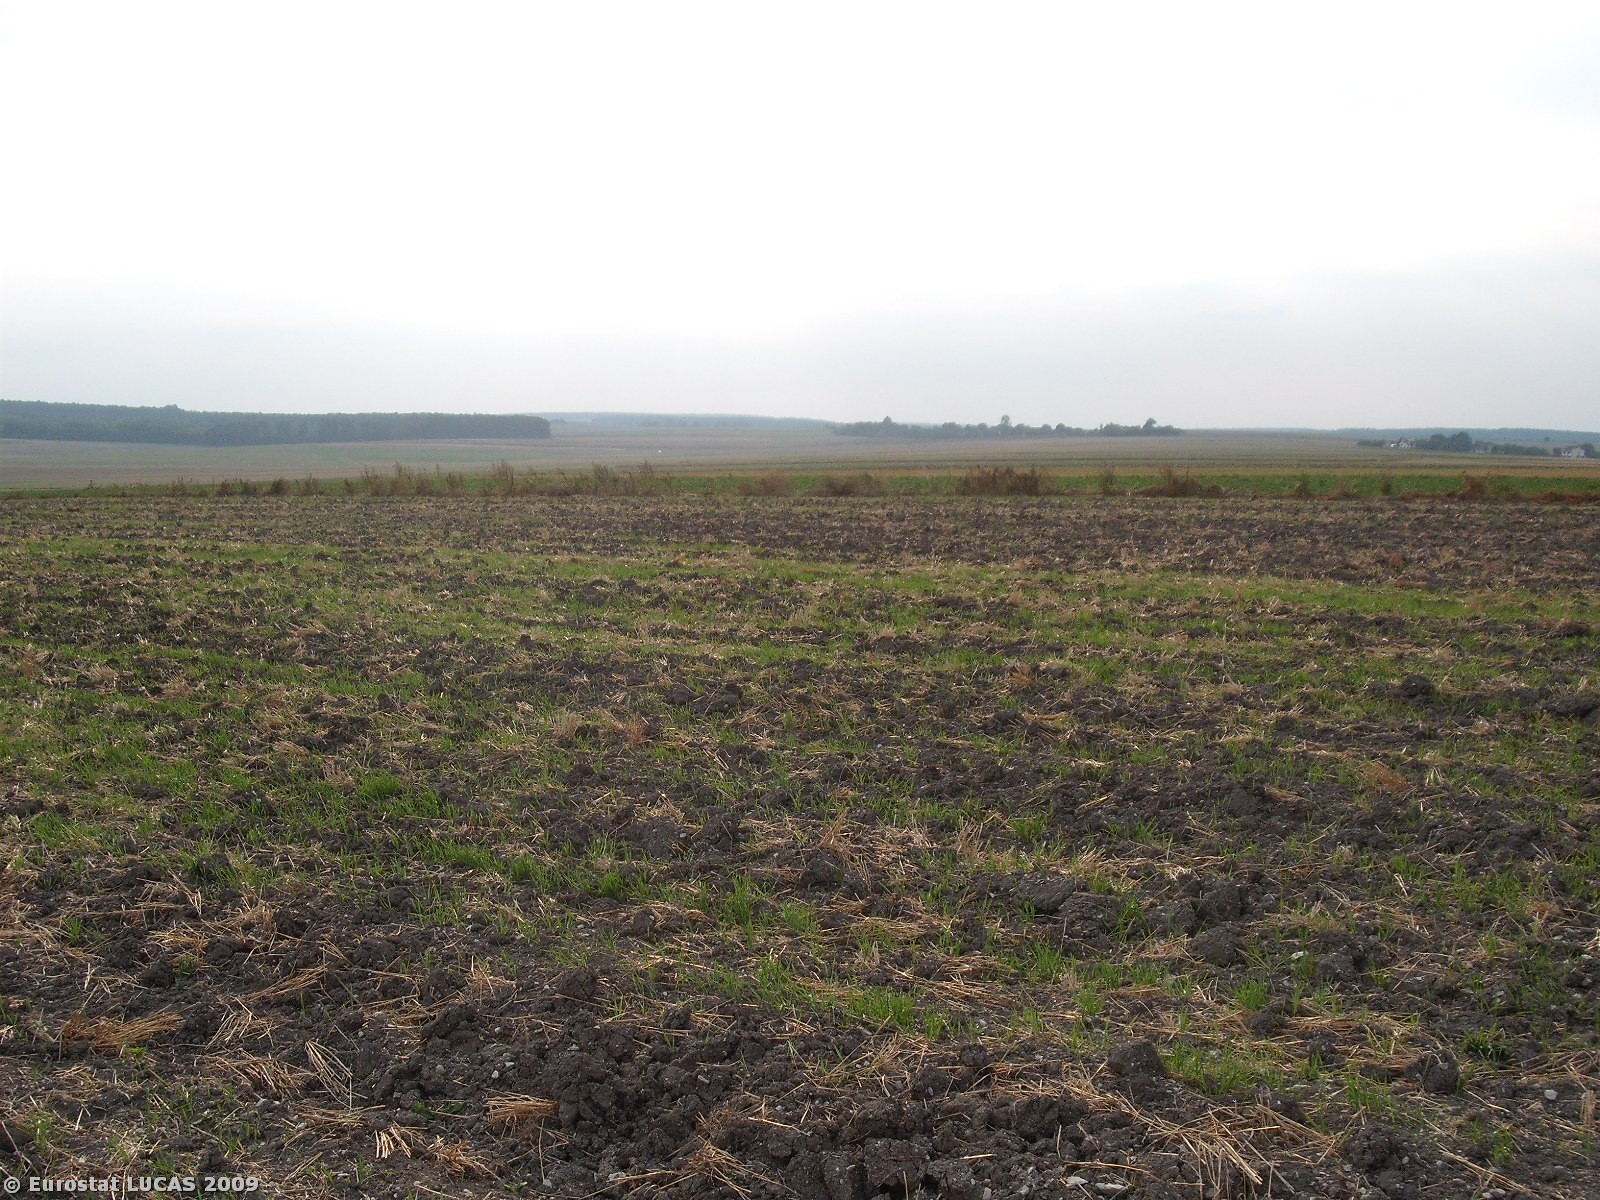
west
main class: Cropland
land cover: Barley
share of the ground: < 10 %
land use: Agriculture (excluding fallow land and kitchen gardens)
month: September
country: PL
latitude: 50.4772
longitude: 20.3086
